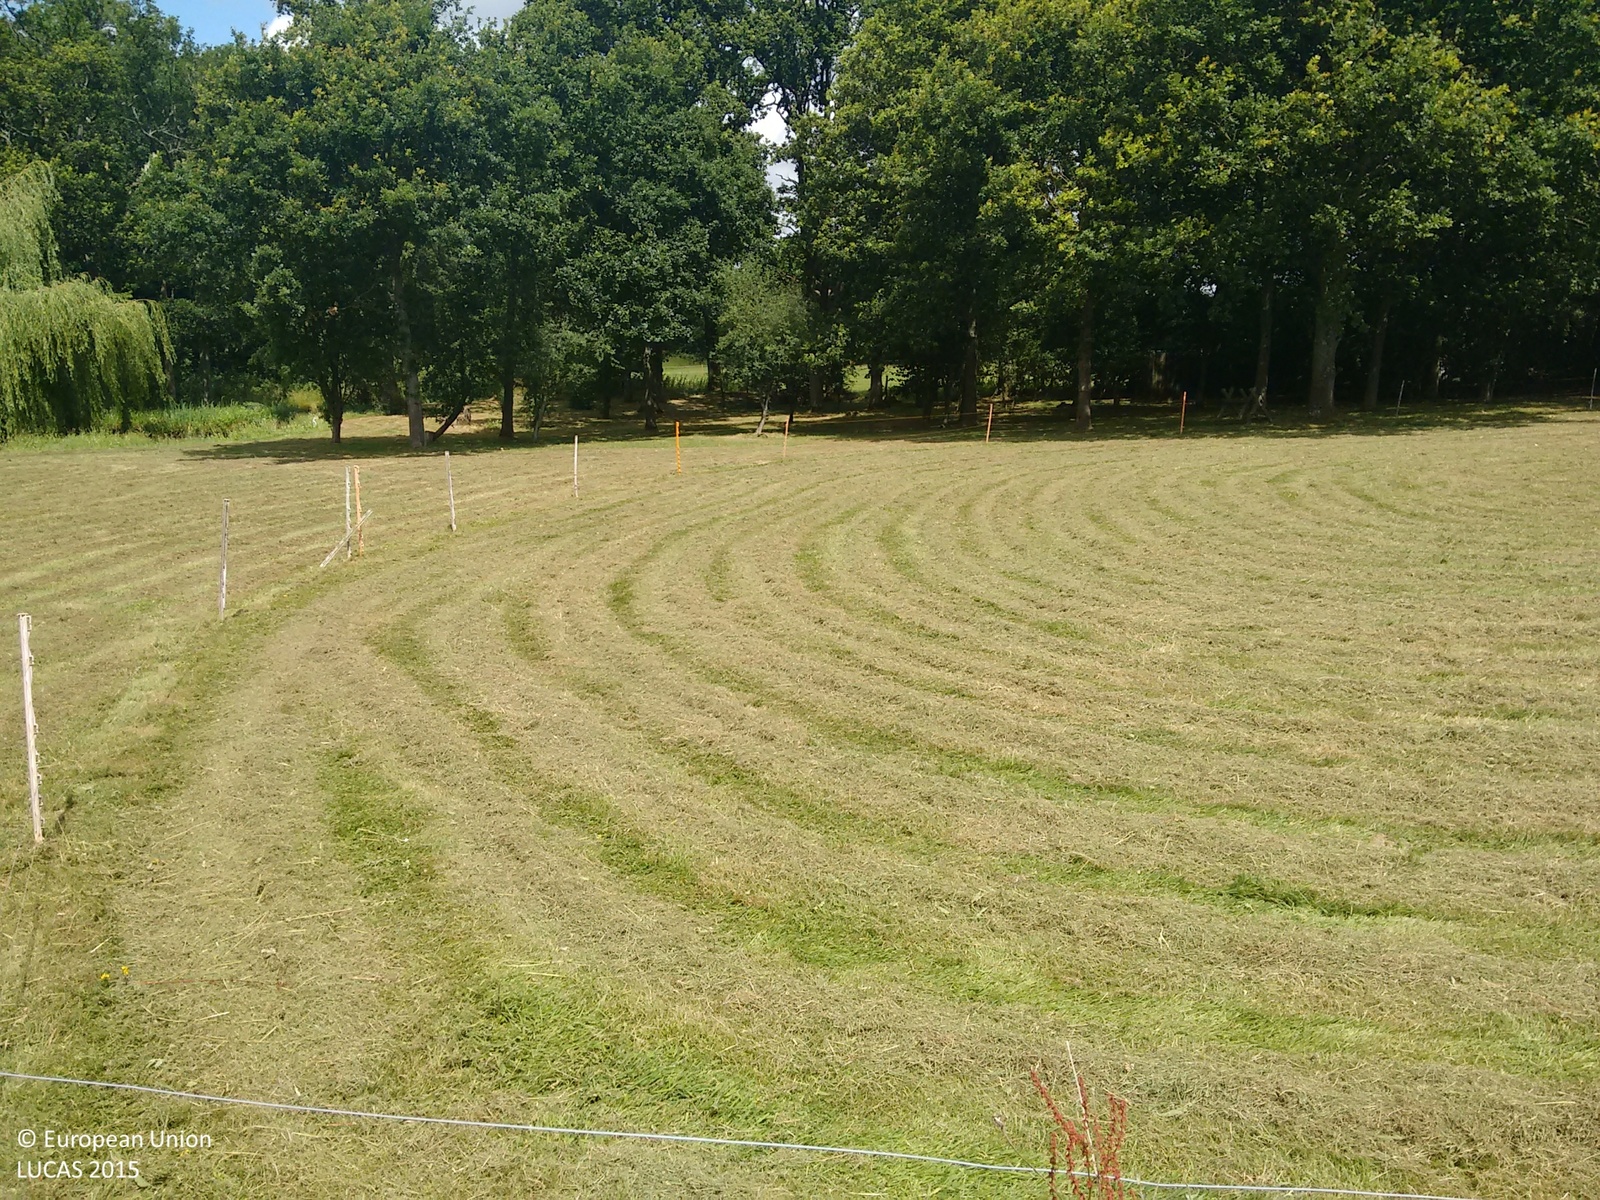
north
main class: Grassland
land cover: Grassland without tree/shrub cover
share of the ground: > 75 %
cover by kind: herbaceous plants 100 %
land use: Residential
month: July
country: GB
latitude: 51.0459
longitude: -0.4359
